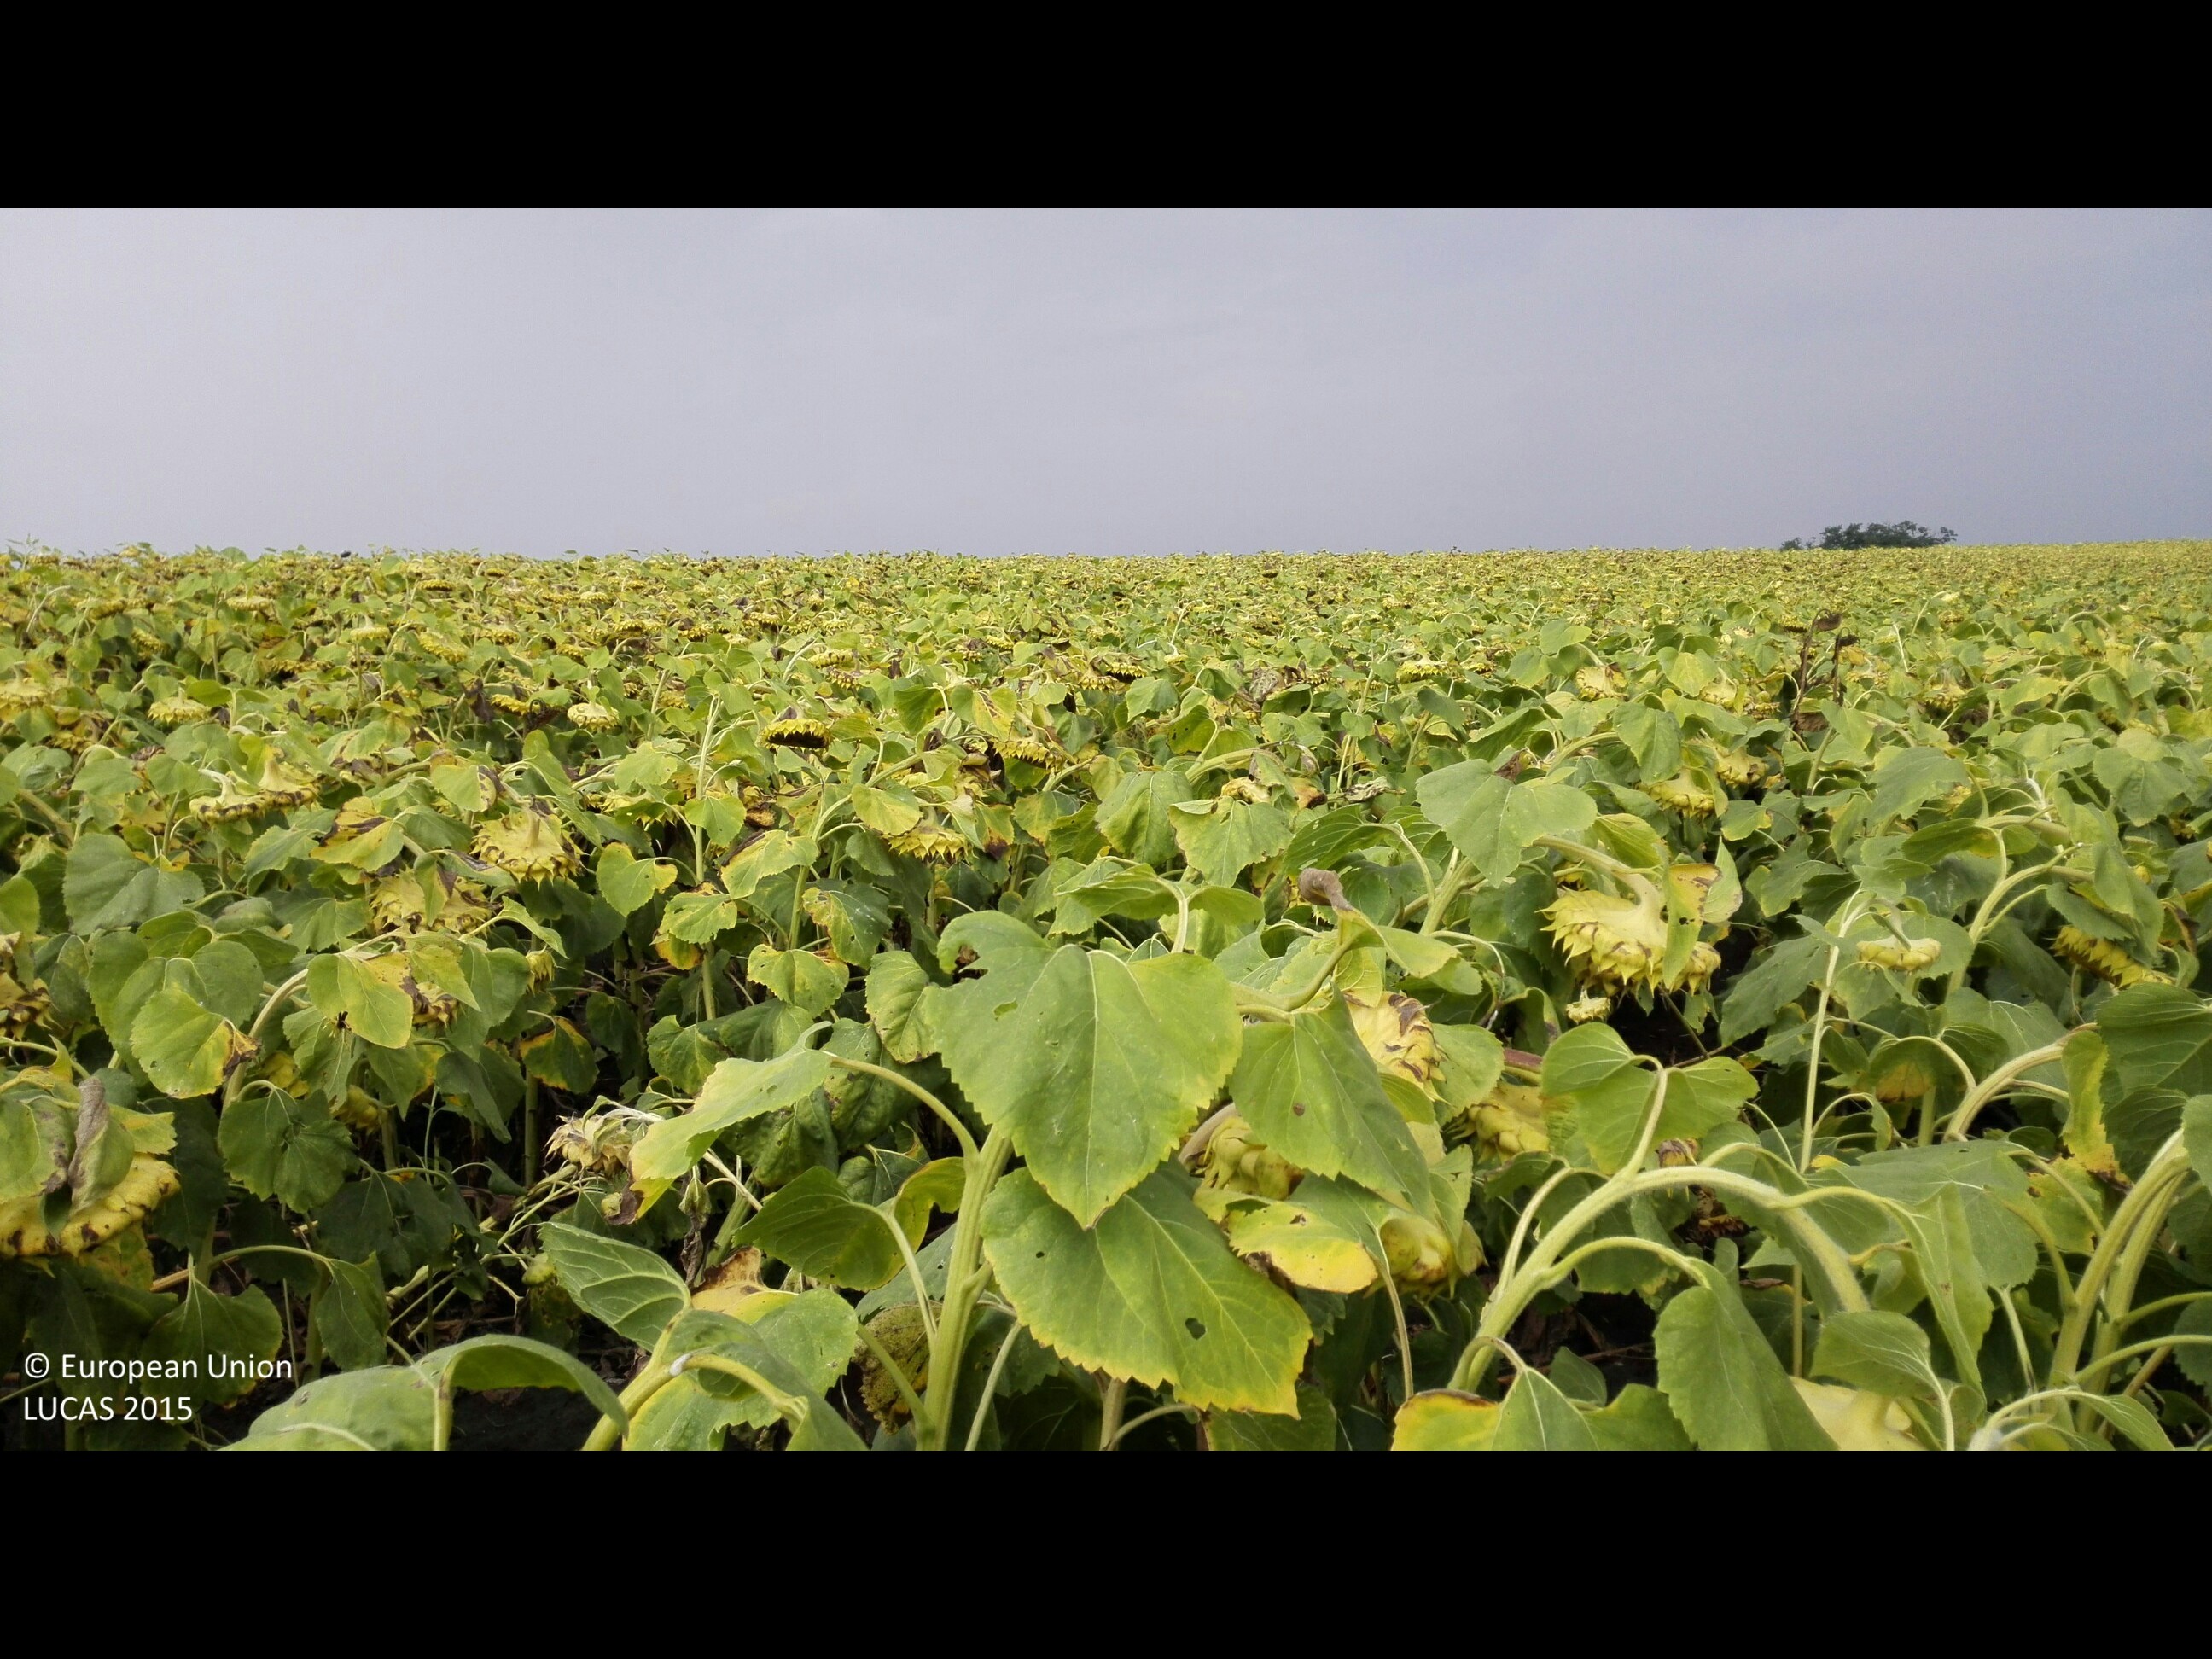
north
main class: Cropland
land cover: Sunflower
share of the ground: > 75 %
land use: Agriculture (excluding fallow land and kitchen gardens)
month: August
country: HU
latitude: 47.3160
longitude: 21.6190
